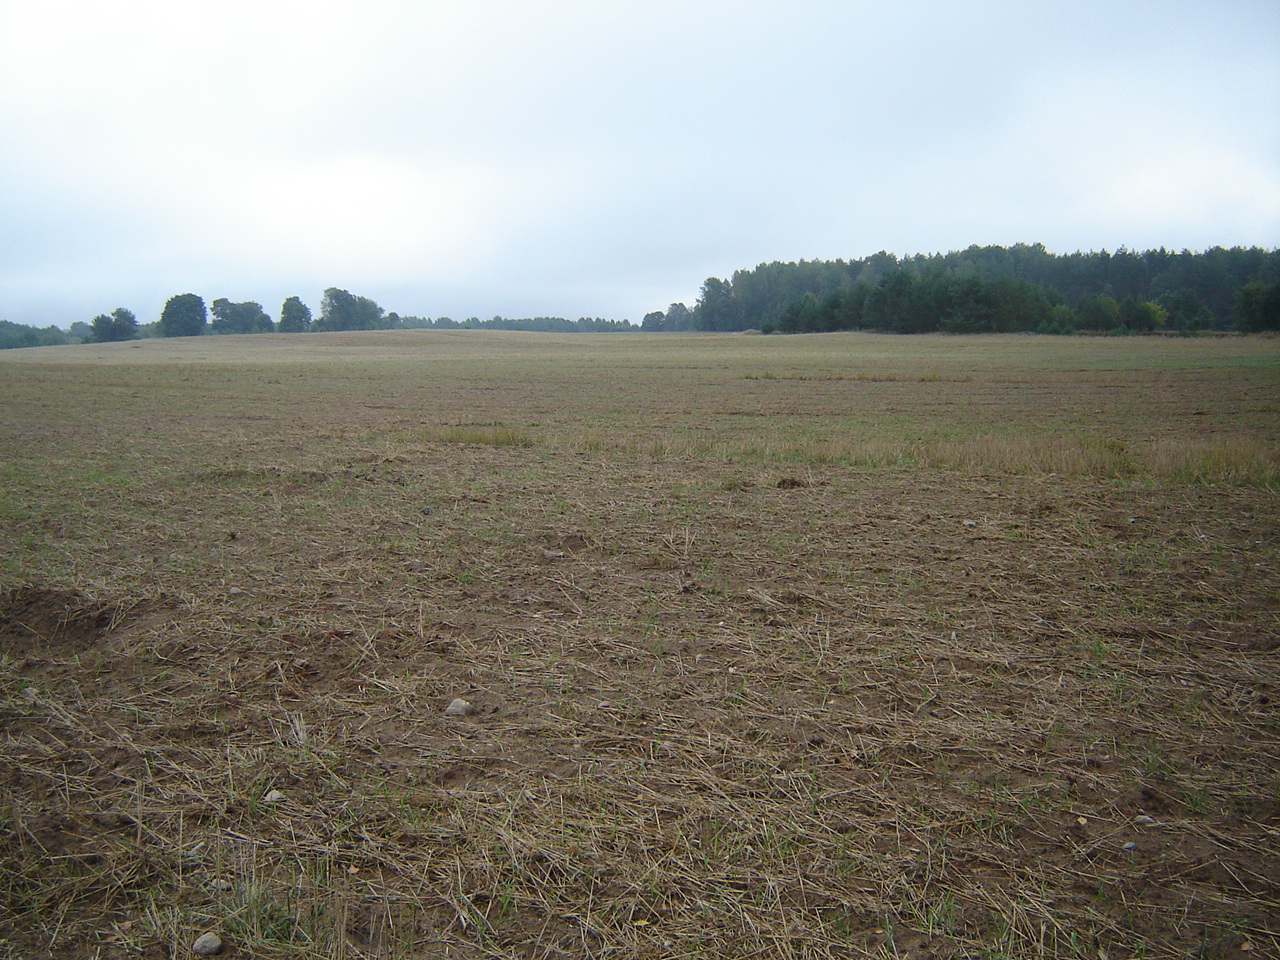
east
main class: Cropland
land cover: Rye
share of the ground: < 10 %
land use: Agriculture (excluding fallow land and kitchen gardens)
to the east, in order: Rye
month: September
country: LT
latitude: 54.2290
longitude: 24.7593
